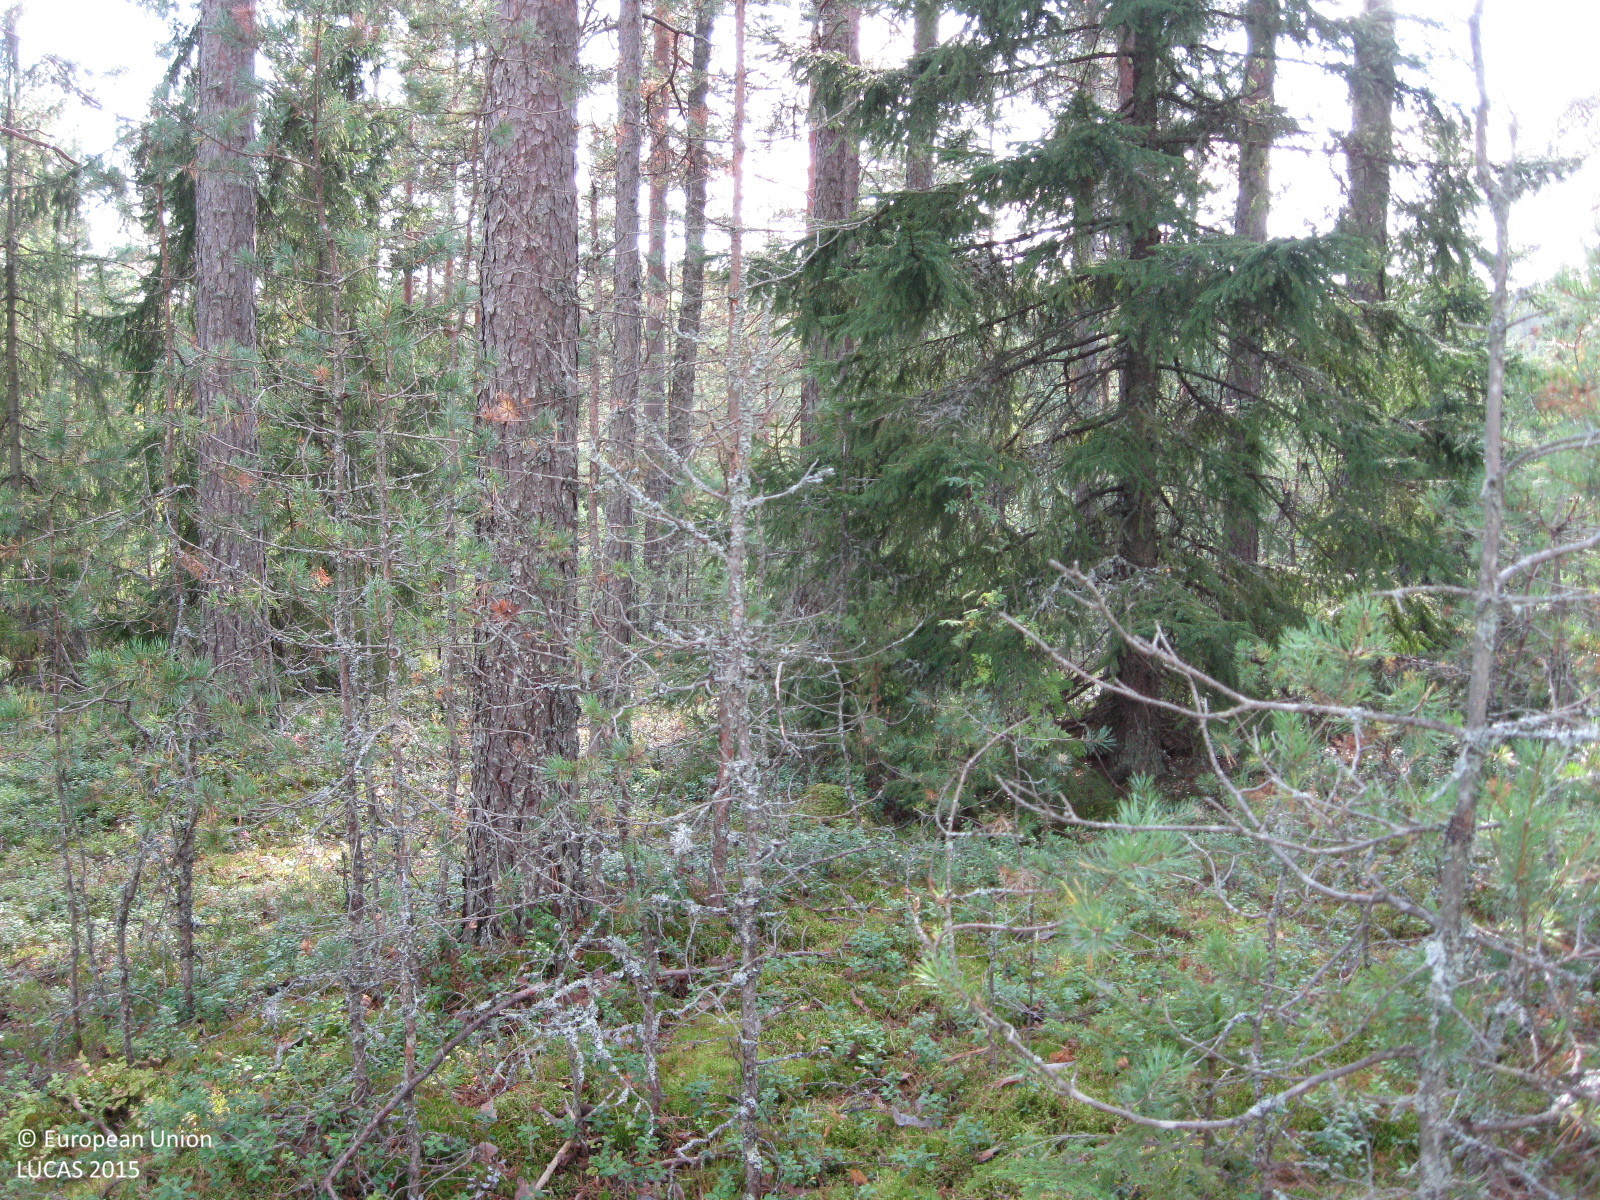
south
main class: Woodland
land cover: Pine dominated coniferous woodland
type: boreal forest
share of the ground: 50 - 75 %
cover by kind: coniferous forest trees 55 %, lichens and mosses 25 %, shrubs 20 %
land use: Forestry
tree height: > 5 m
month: September
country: FI
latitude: 60.3560
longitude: 24.5543
